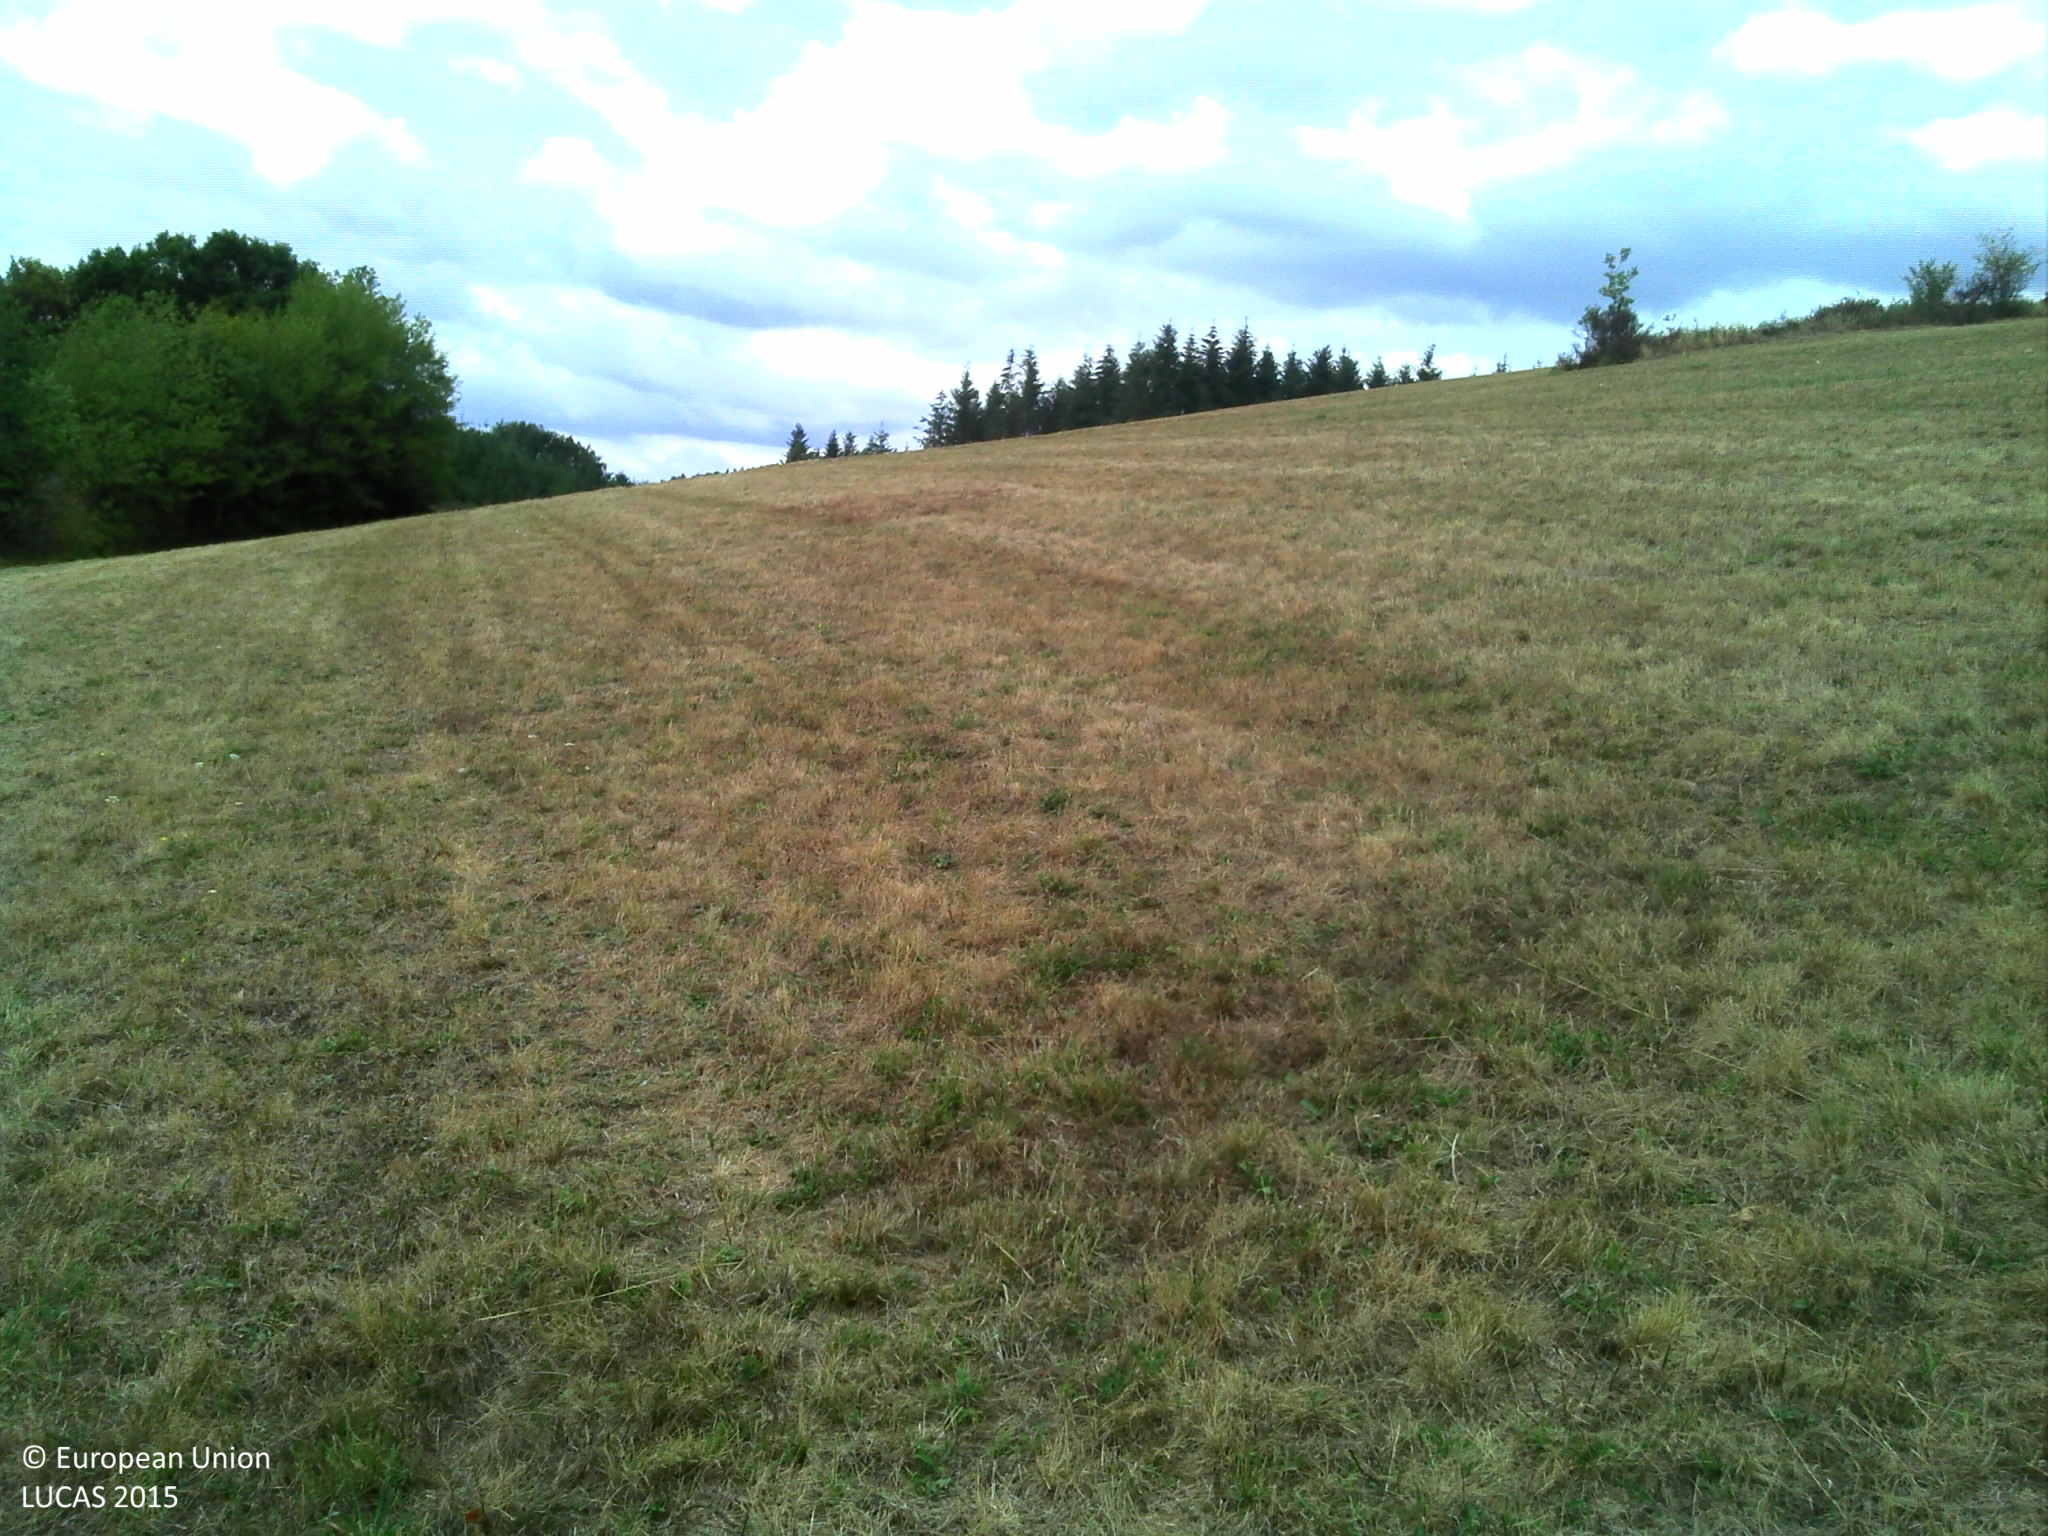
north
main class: Grassland
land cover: Grassland without tree/shrub cover
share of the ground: > 75 %
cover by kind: herbaceous plants 100 %
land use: Agriculture (excluding fallow land and kitchen gardens)
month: August
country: FR
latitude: 46.0657
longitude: 4.5081
